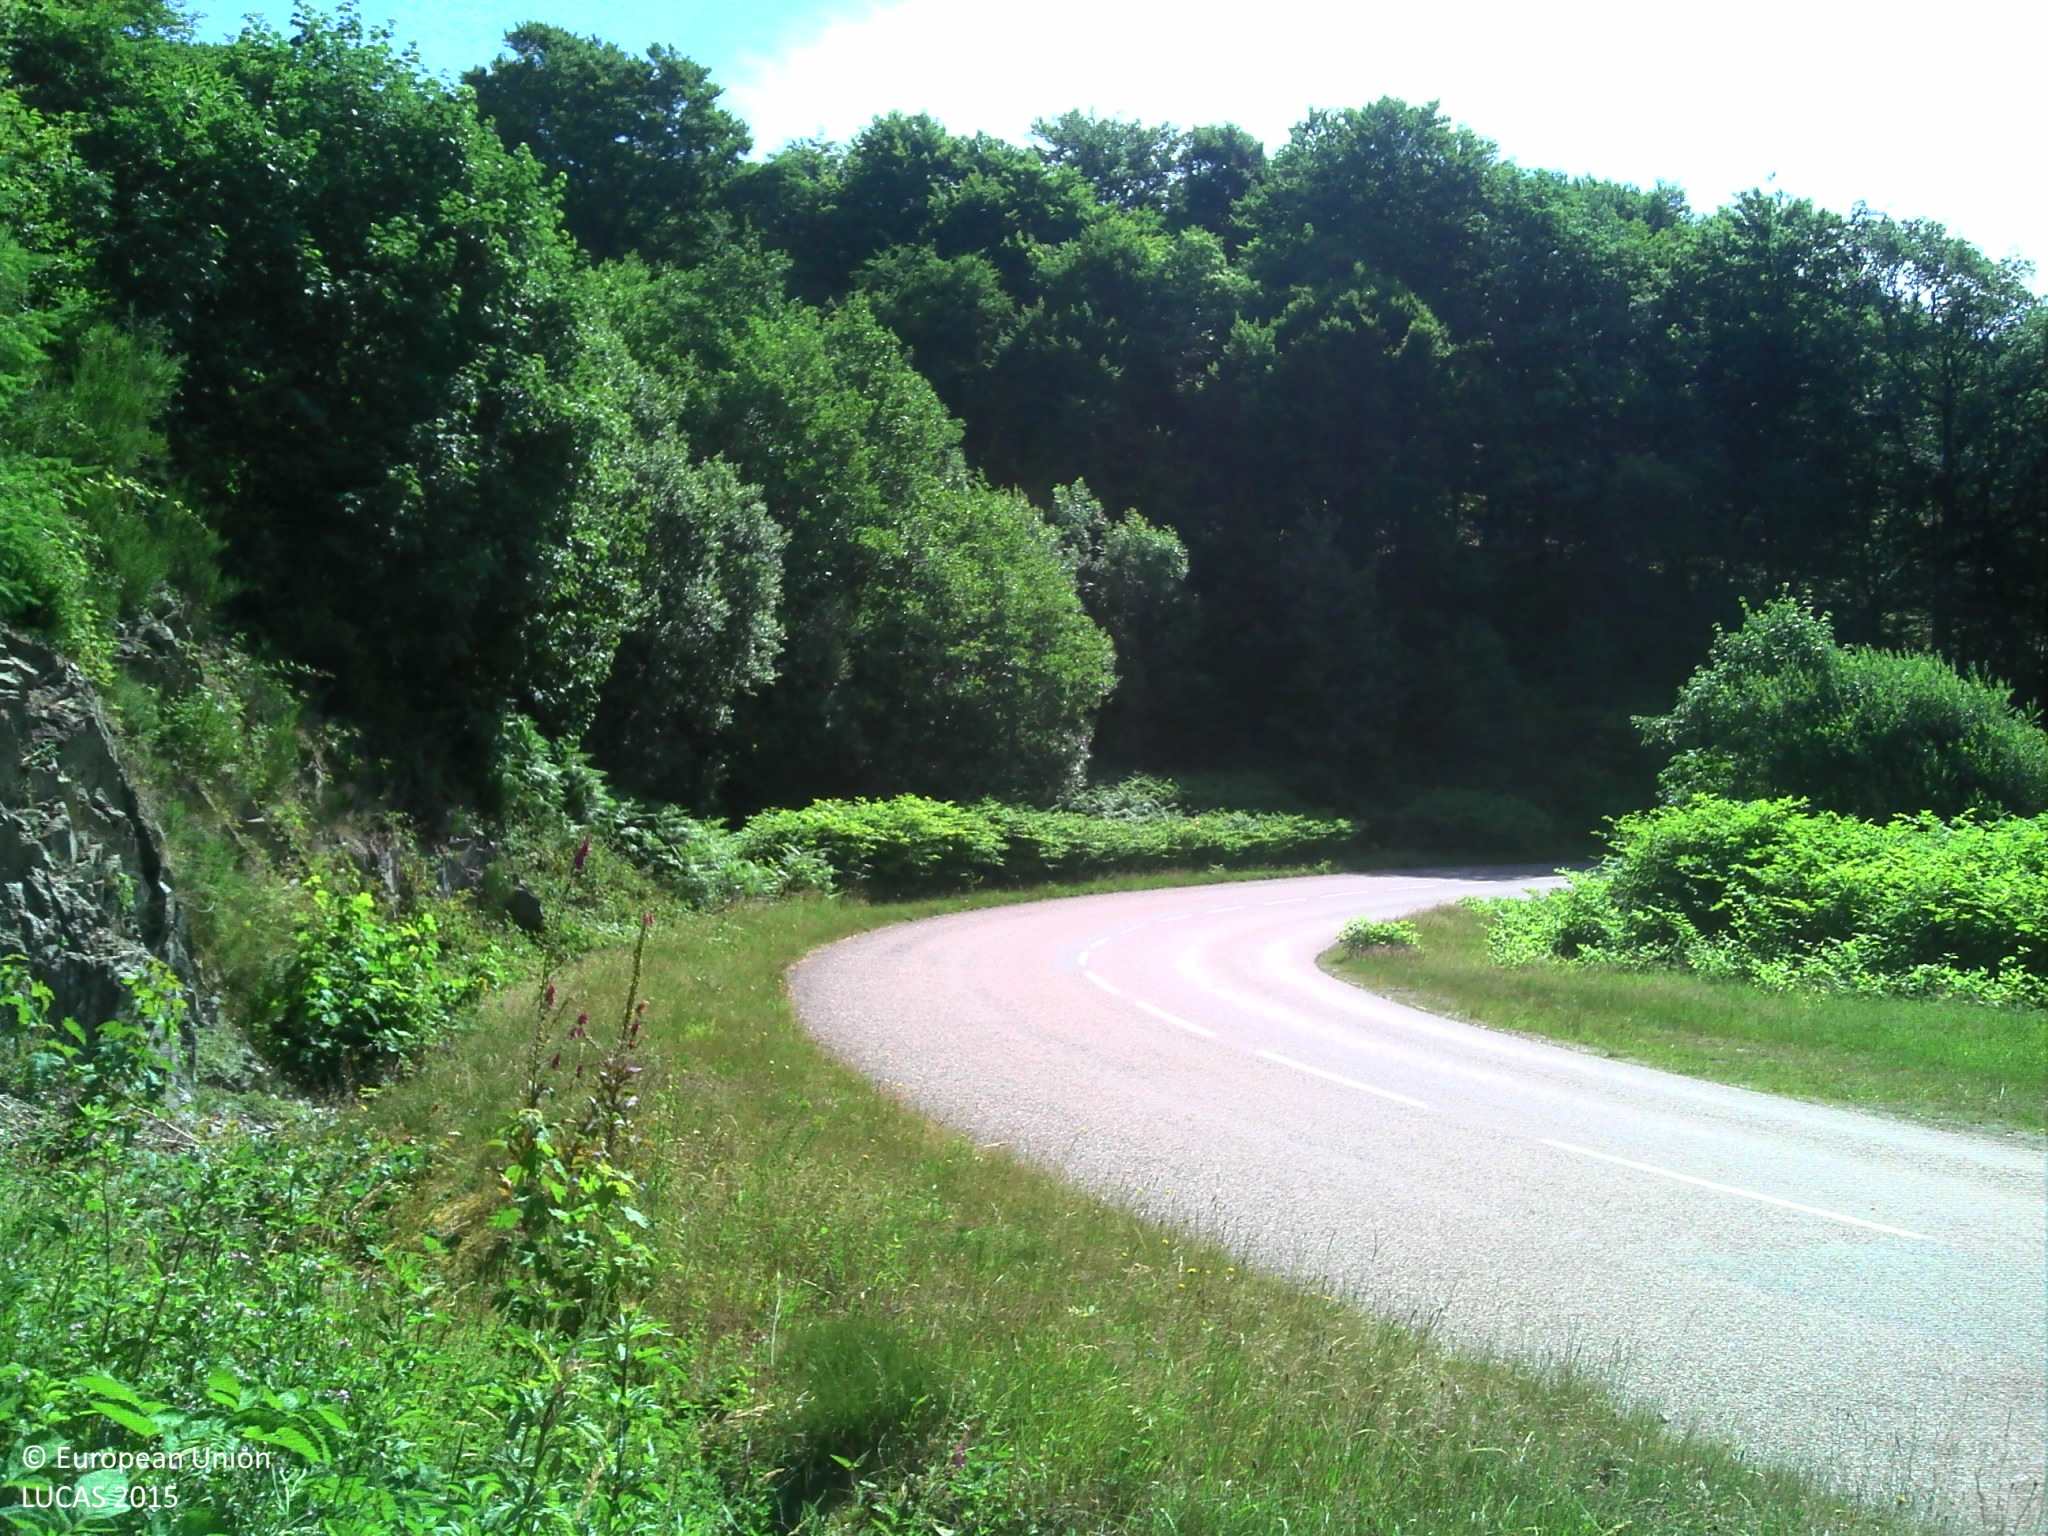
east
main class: Grassland
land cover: Spontaneously vegetated surfaces
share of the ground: > 75 %
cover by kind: herbaceous plants 95 %, shrubs 5 %
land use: Semi-natural and natural areas not in use
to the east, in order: Spontaneously vegetated surfaces; Ditches and canals; Grass margins; Paved roads, cycling and walking lanes; Grass margins; Ditches and canals; Broadleaved woodland; Fences; Grassland without tree/shrub cover; Fences; Broadleaved woodland
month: June
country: FR
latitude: 46.9423
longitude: 4.0218
